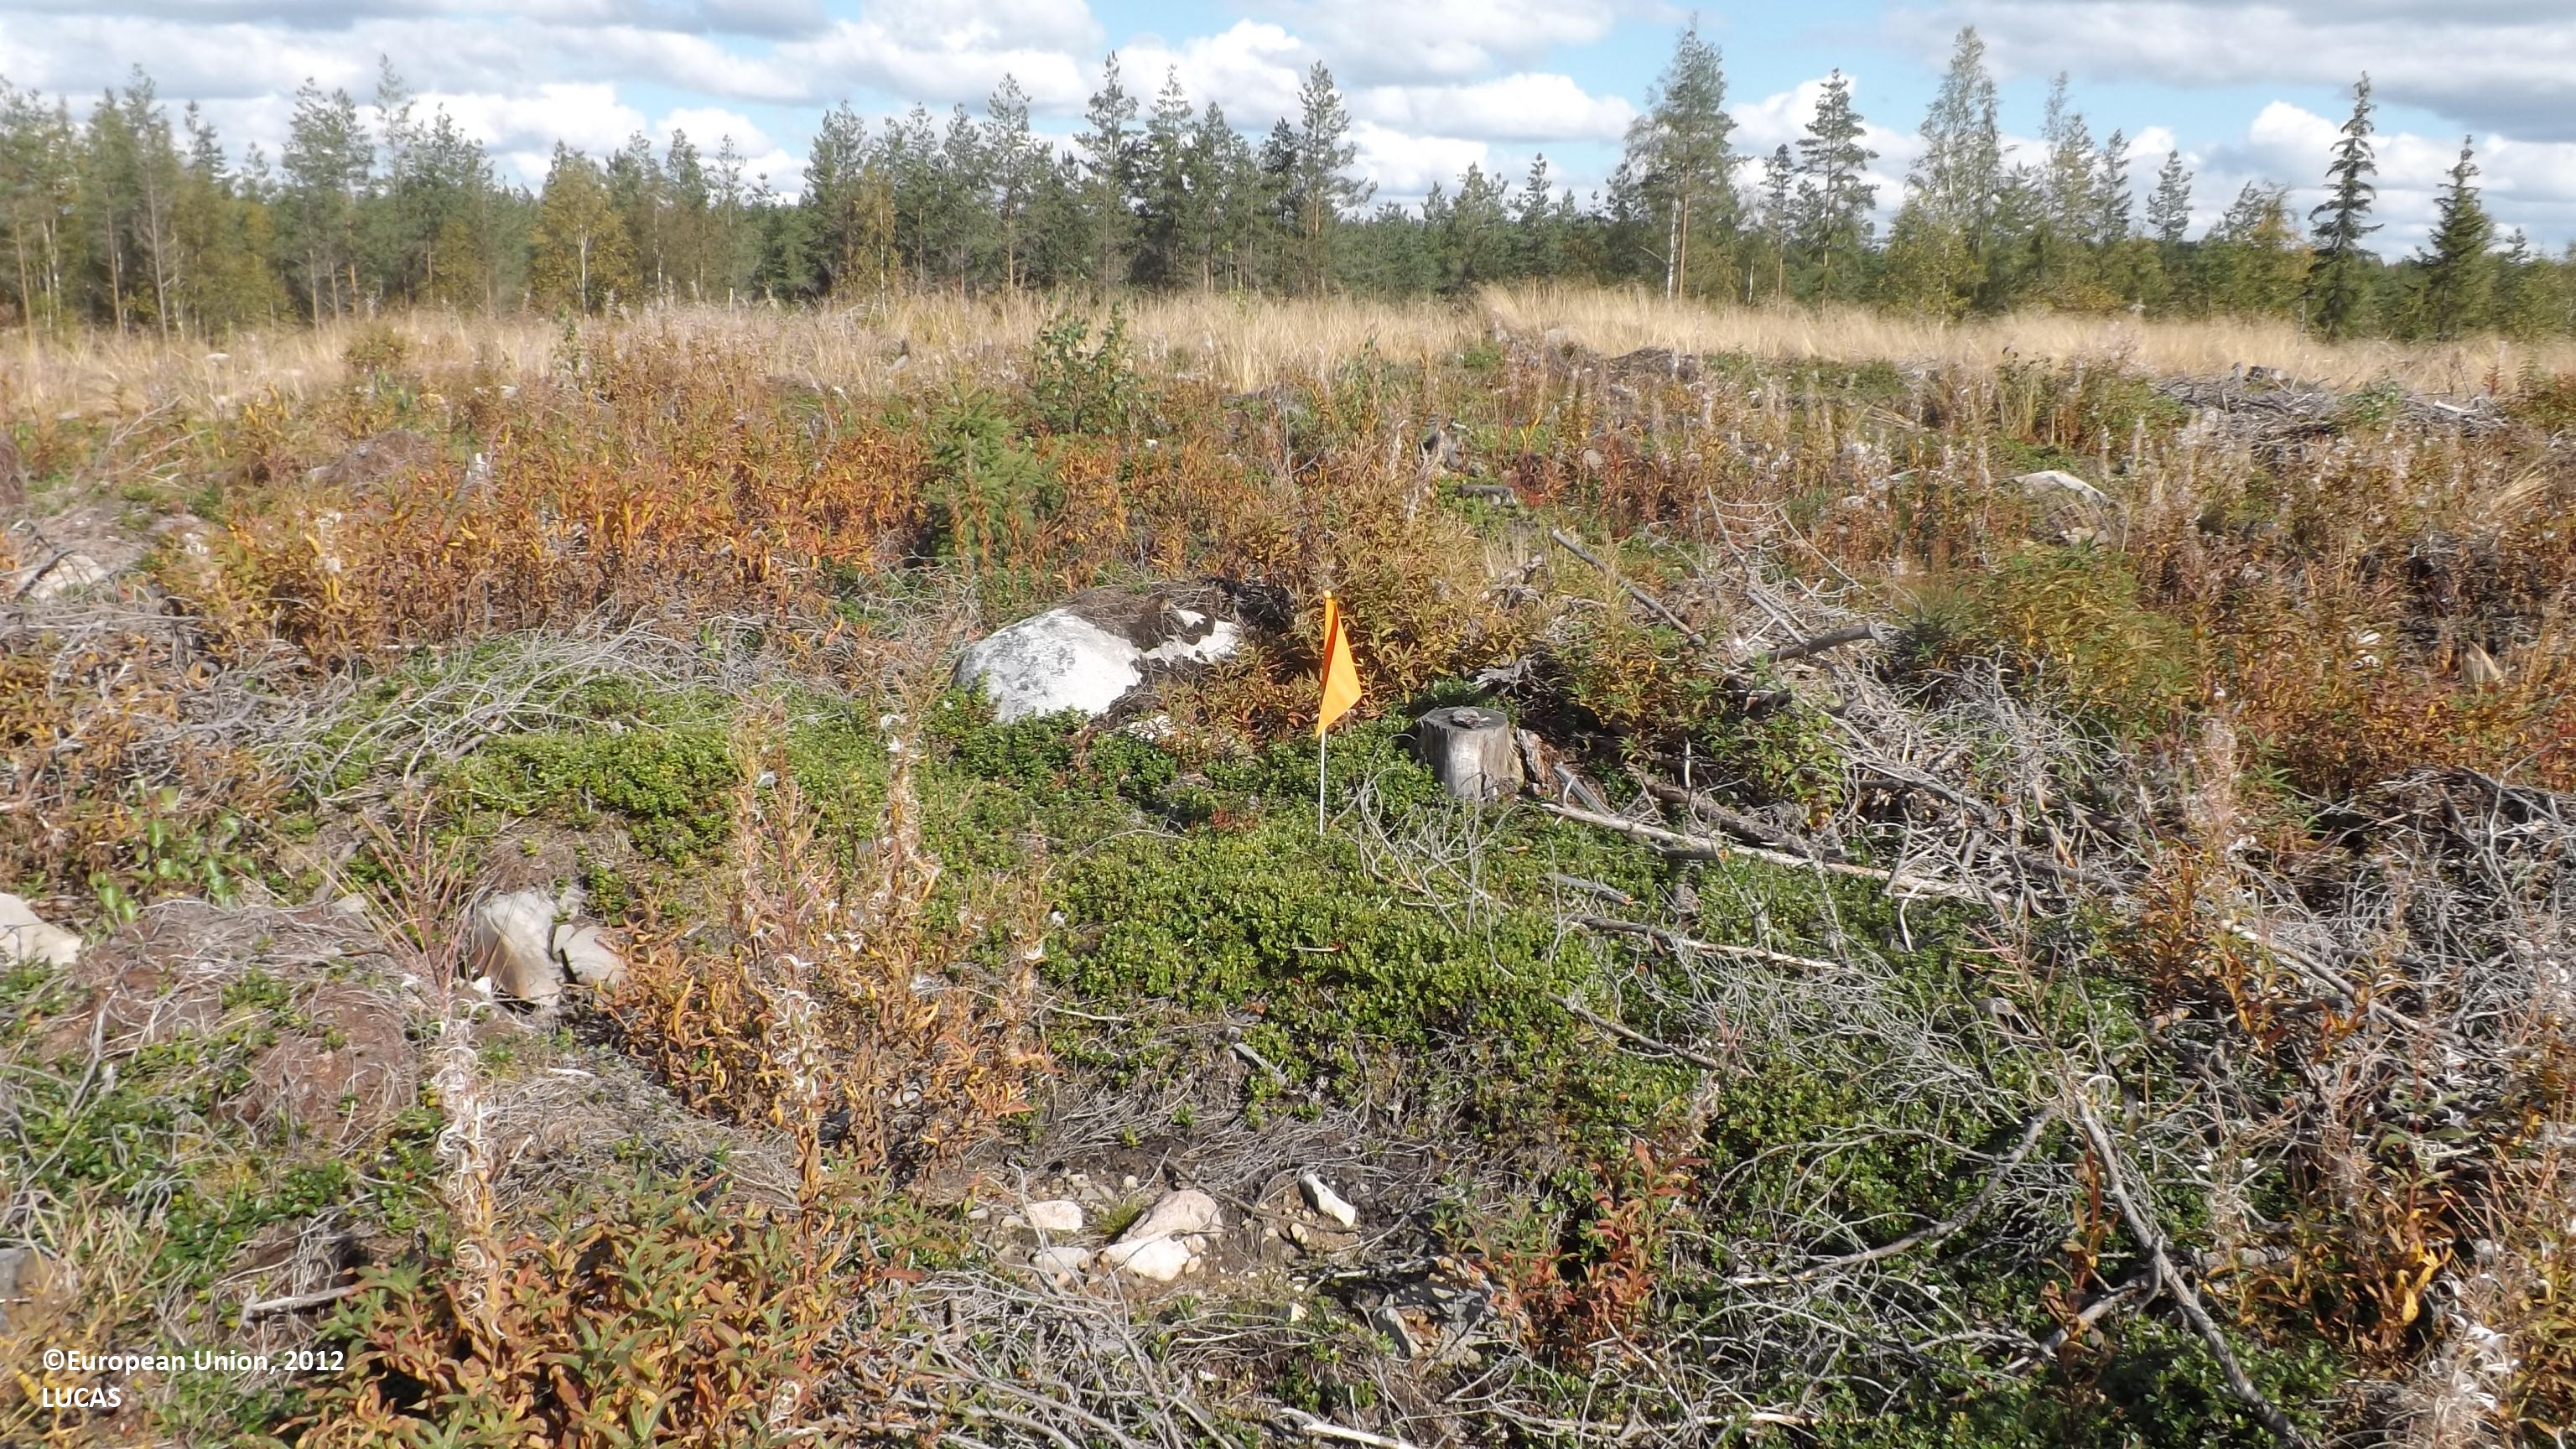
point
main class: Shrubland
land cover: Shrubland without tree cover
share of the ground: 25 - 50 %
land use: Forestry
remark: Clear cut
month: August
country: FI
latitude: 63.6466
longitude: 23.5696
